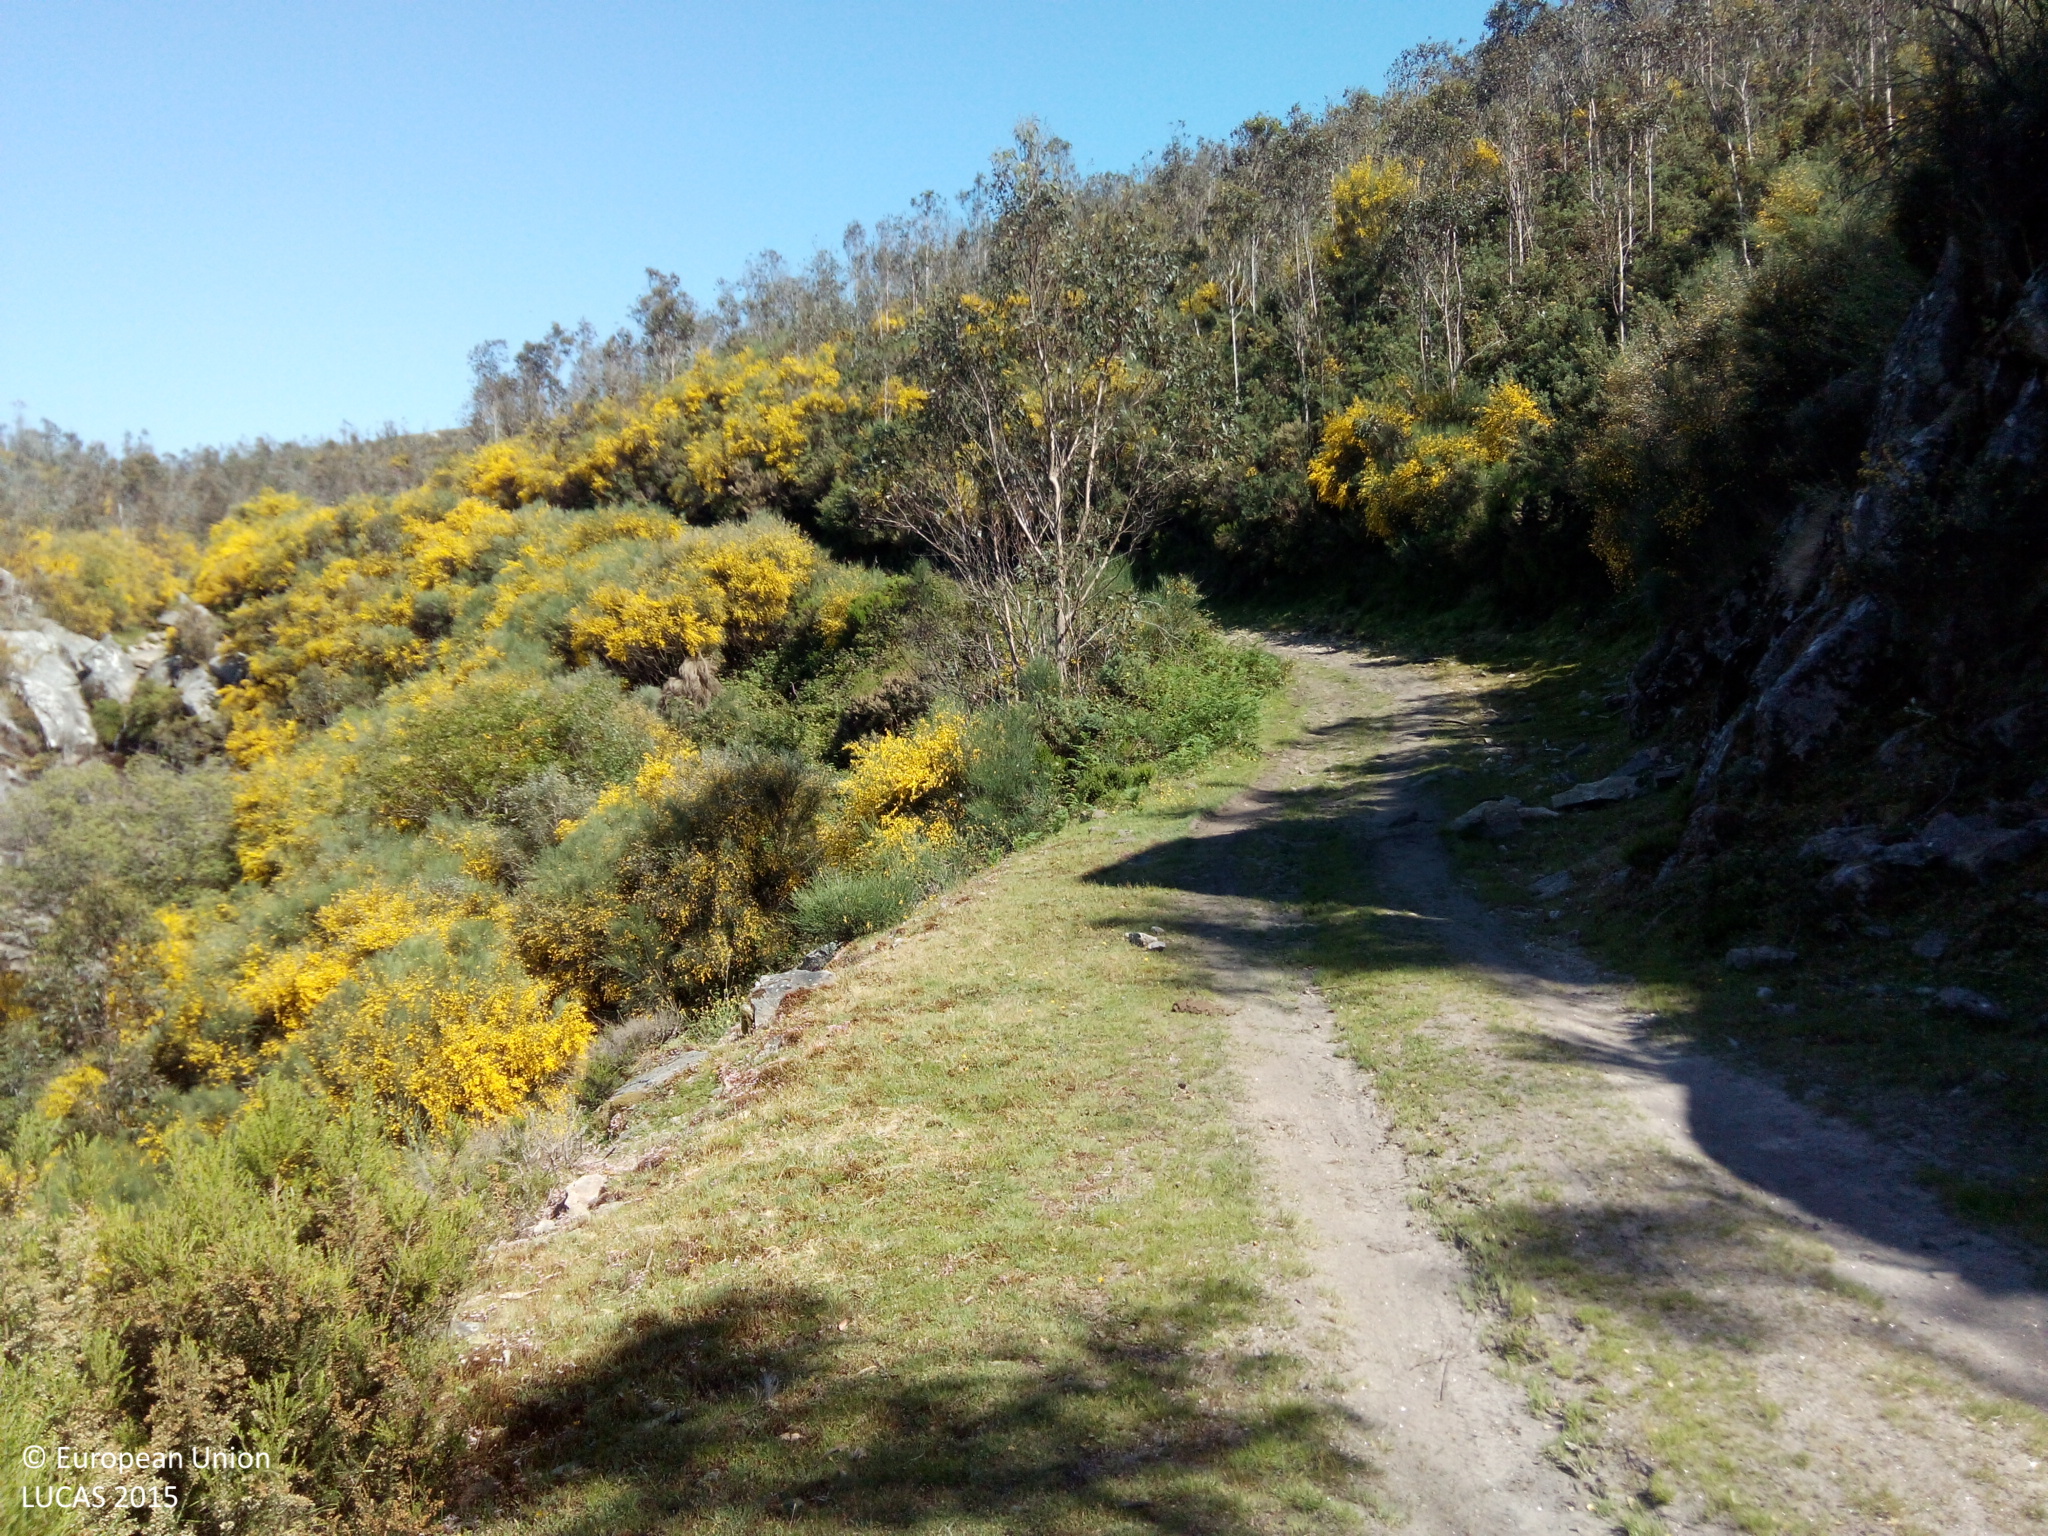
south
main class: Woodland
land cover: Broadleaved woodland
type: exotic forest
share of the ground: > 75 %
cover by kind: broadleaved forest trees 100 %
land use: Forestry
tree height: > 5 m
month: May
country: ES
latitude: 42.0547
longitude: -8.8184
